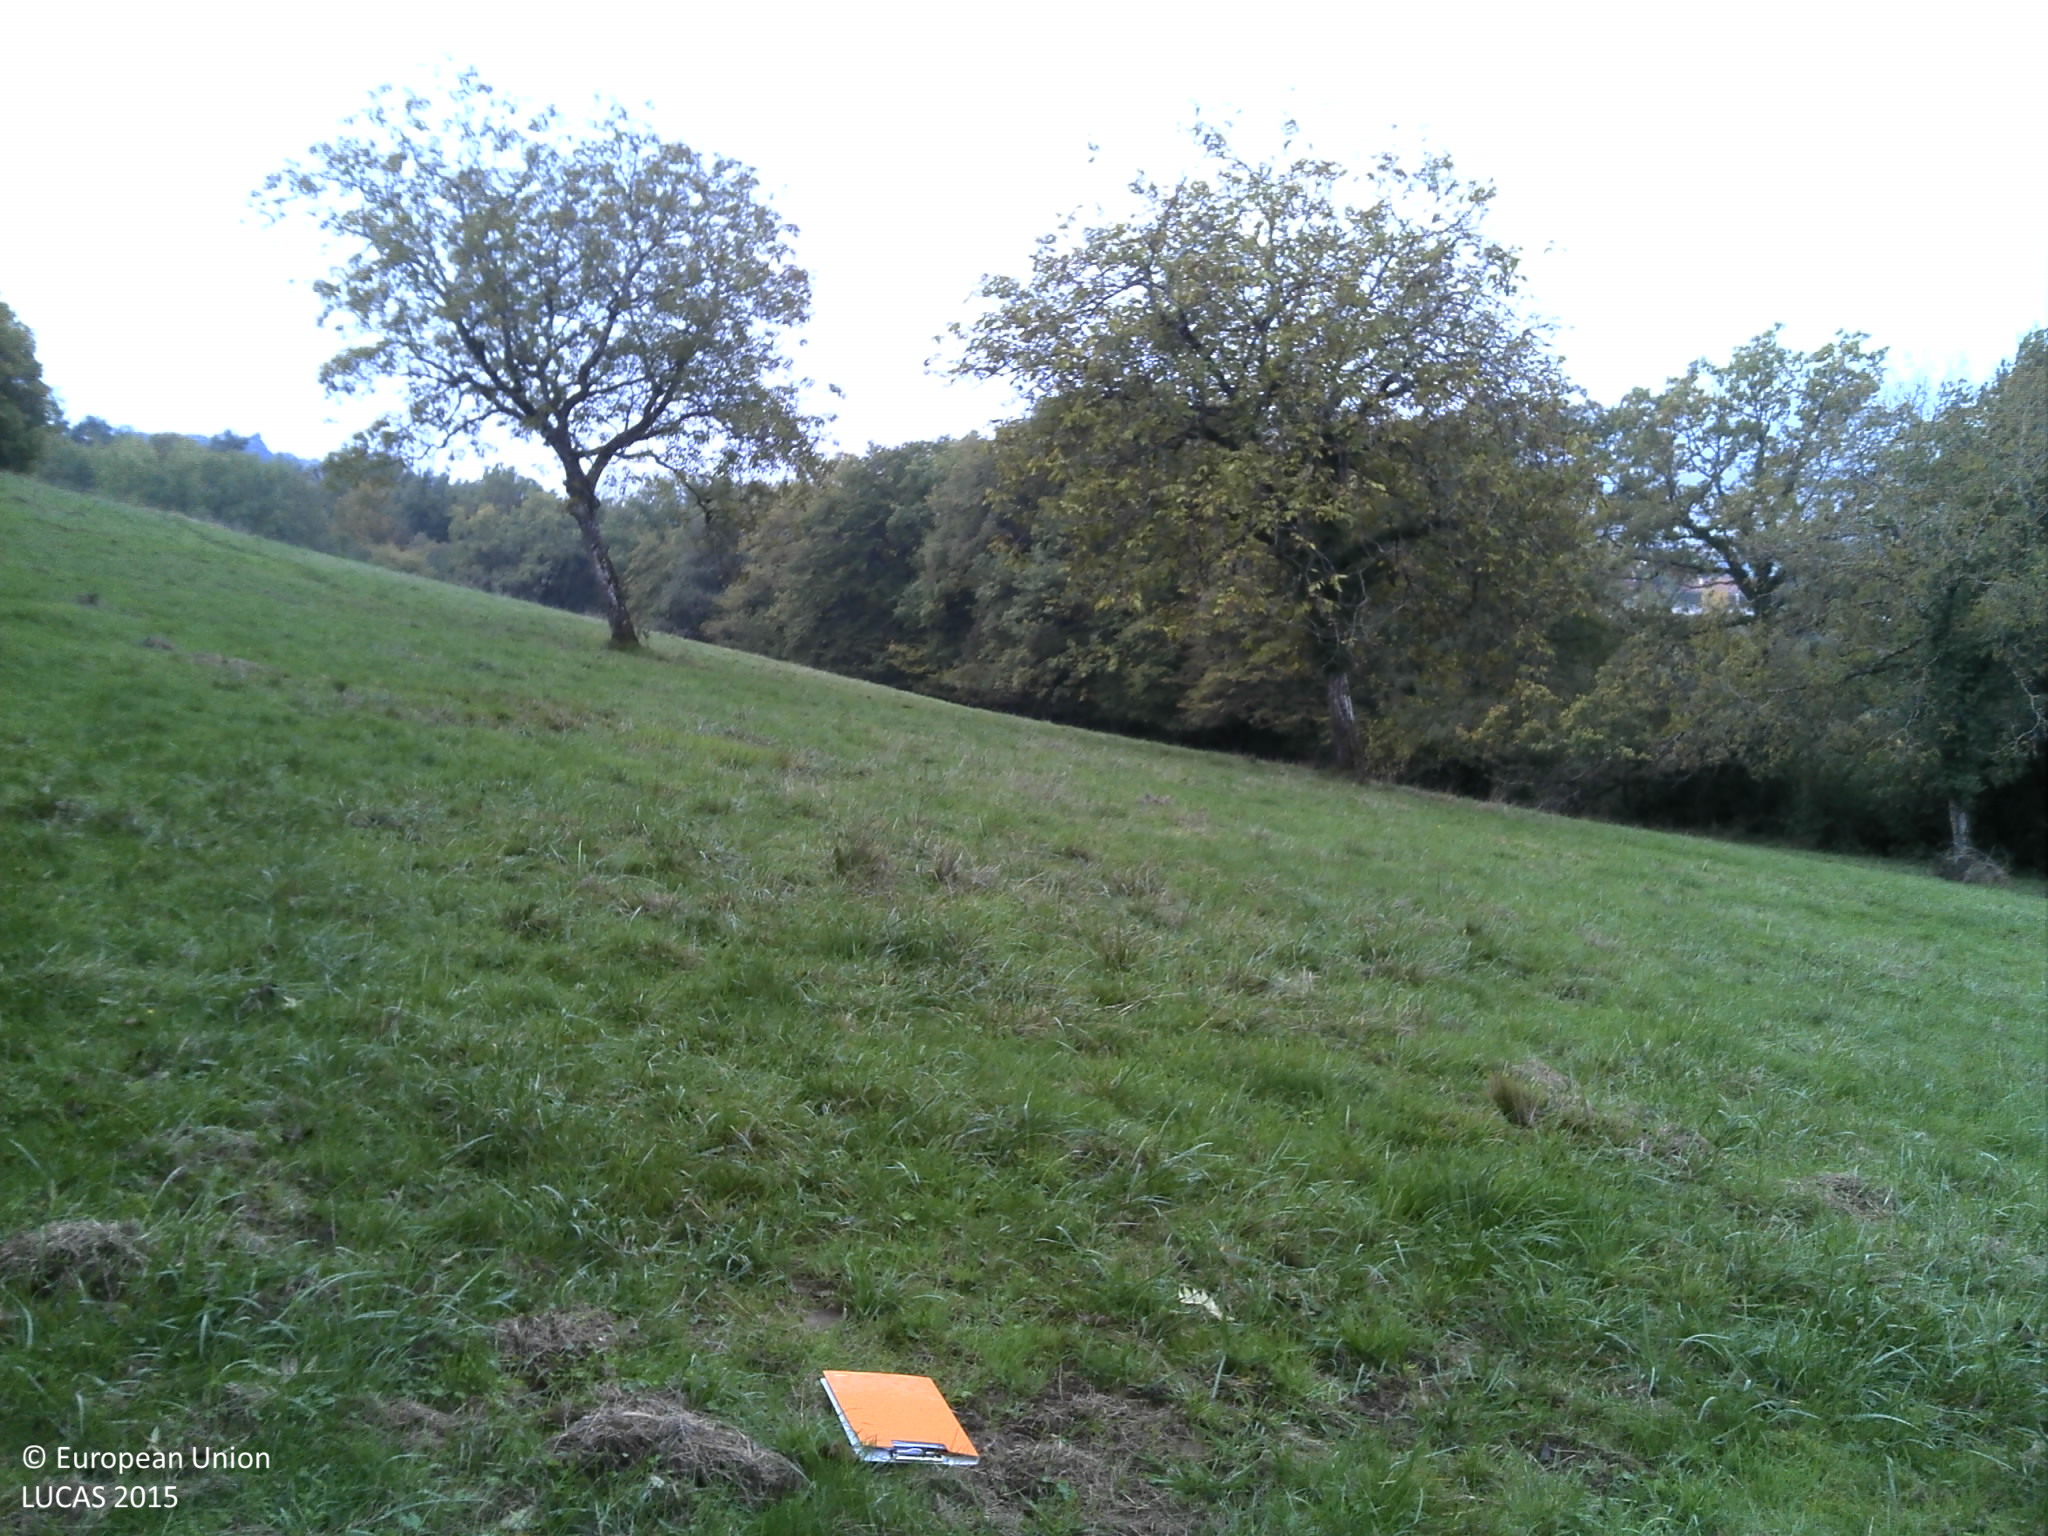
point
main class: Grassland
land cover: Grassland with sparse tree/shrub cover
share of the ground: > 75 %
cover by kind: herbaceous plants 95 %, broadleaved forest trees 5 %
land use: Agriculture (excluding fallow land and kitchen gardens)
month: October
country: FR
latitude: 46.1050
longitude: 5.3330
